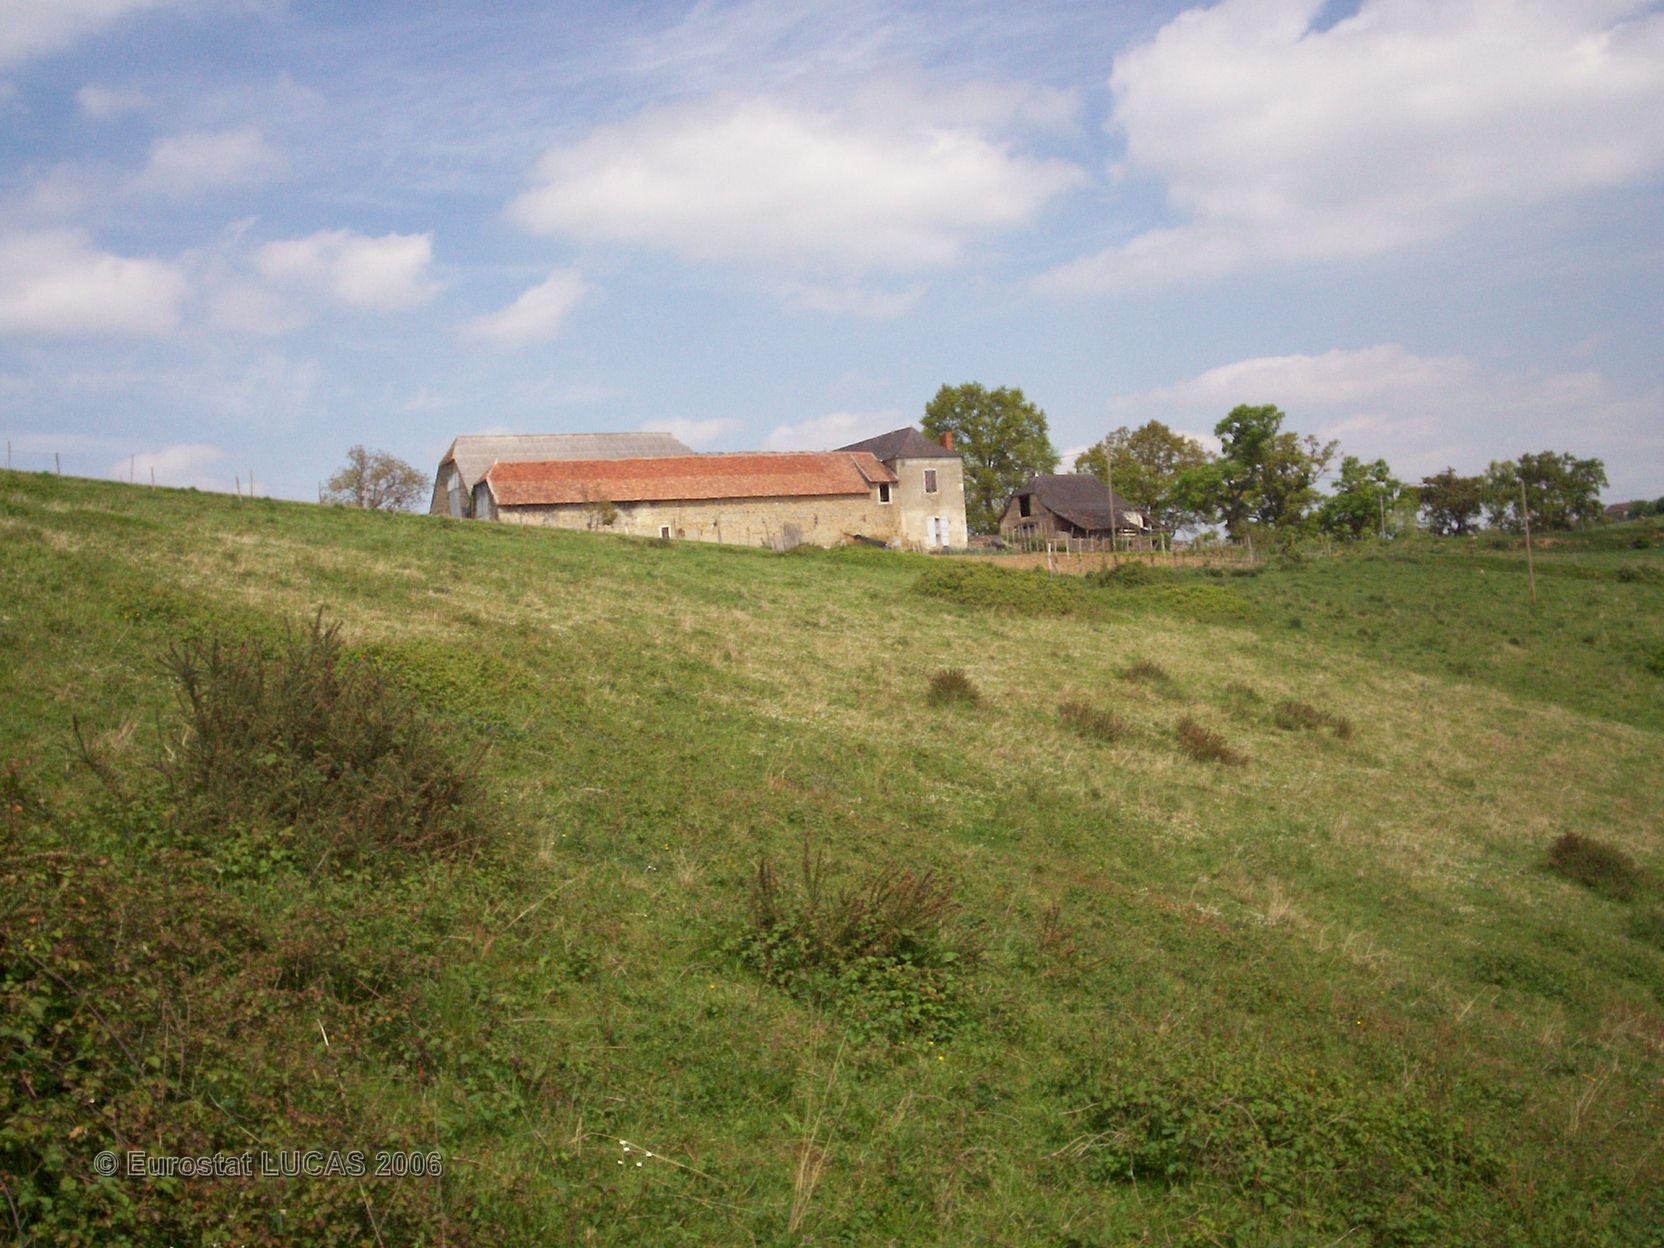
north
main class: Grassland
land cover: Grassland without tree/shrub cover
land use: Agriculture (excluding fallow land and kitchen gardens)
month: April
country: FR
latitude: 43.3305
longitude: -0.6278
